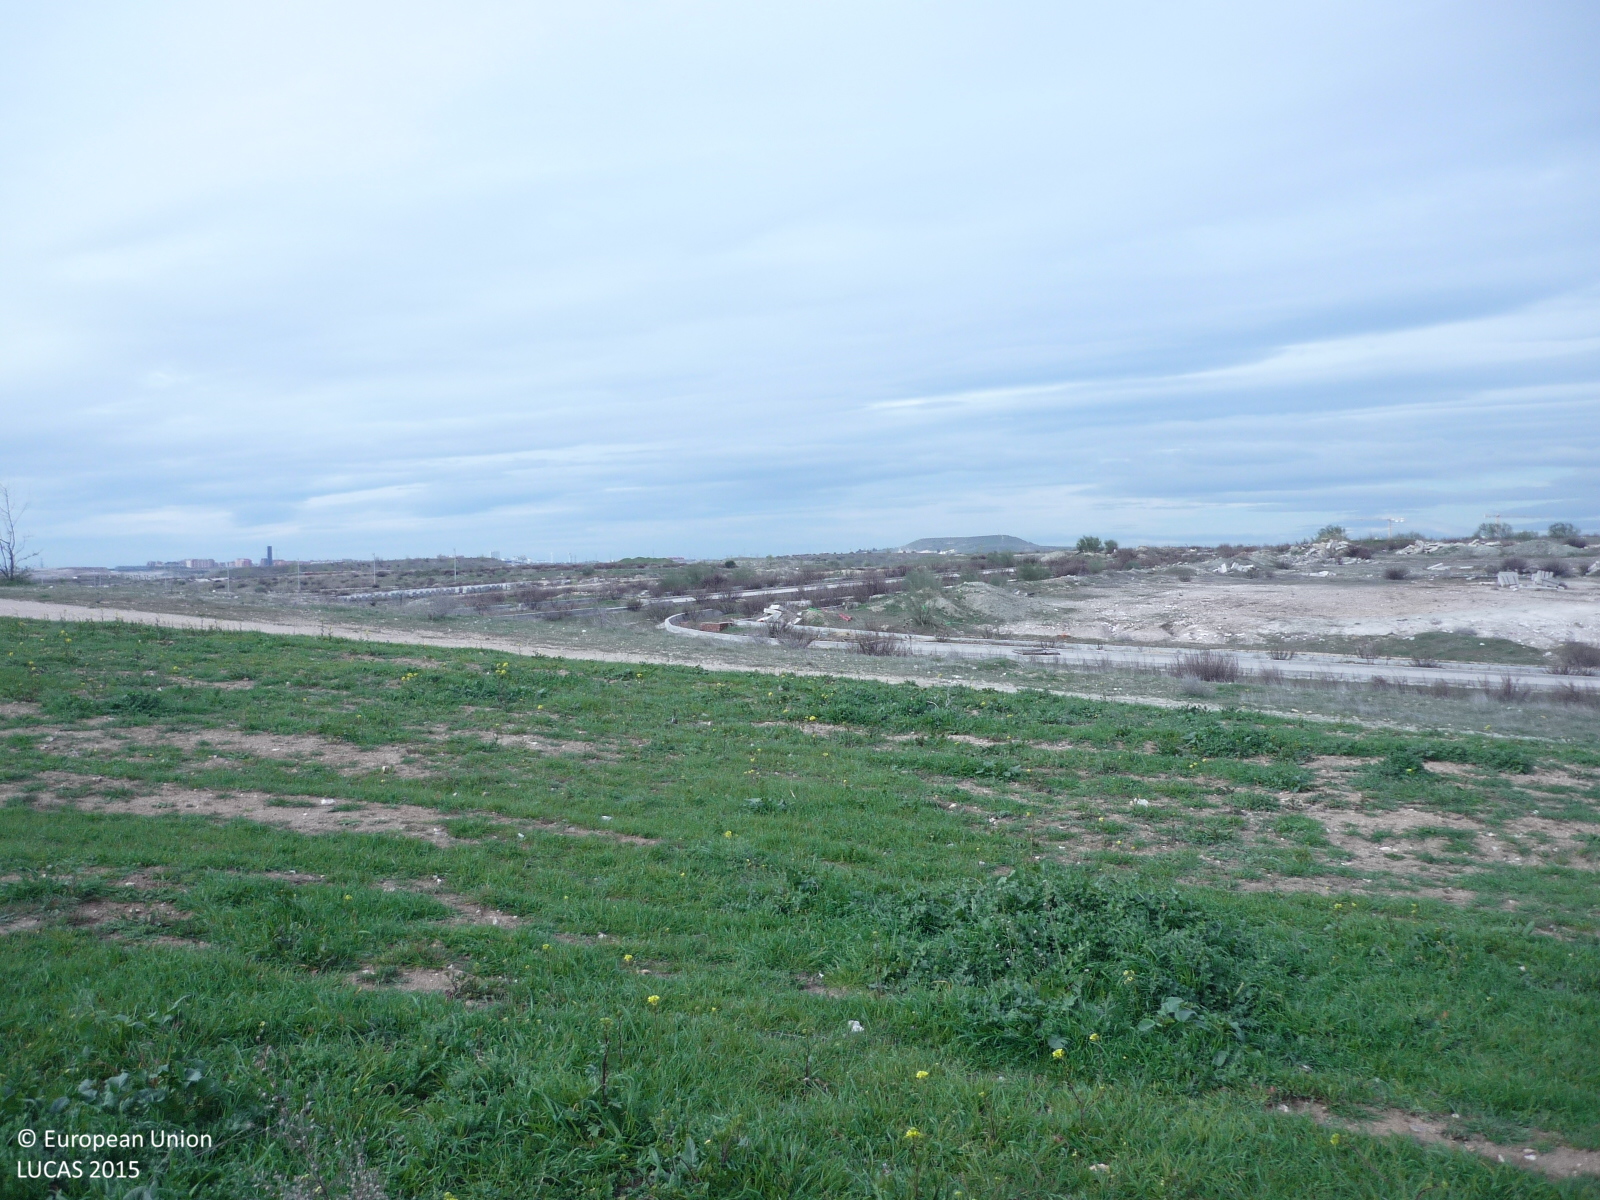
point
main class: Grassland
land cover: Spontaneously vegetated surfaces
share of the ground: > 75 %
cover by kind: herbaceous plants 90 %, unconsolidated bare surface 10 %
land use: Abandoned areas
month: March
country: ES
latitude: 40.4030
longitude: -3.5502
